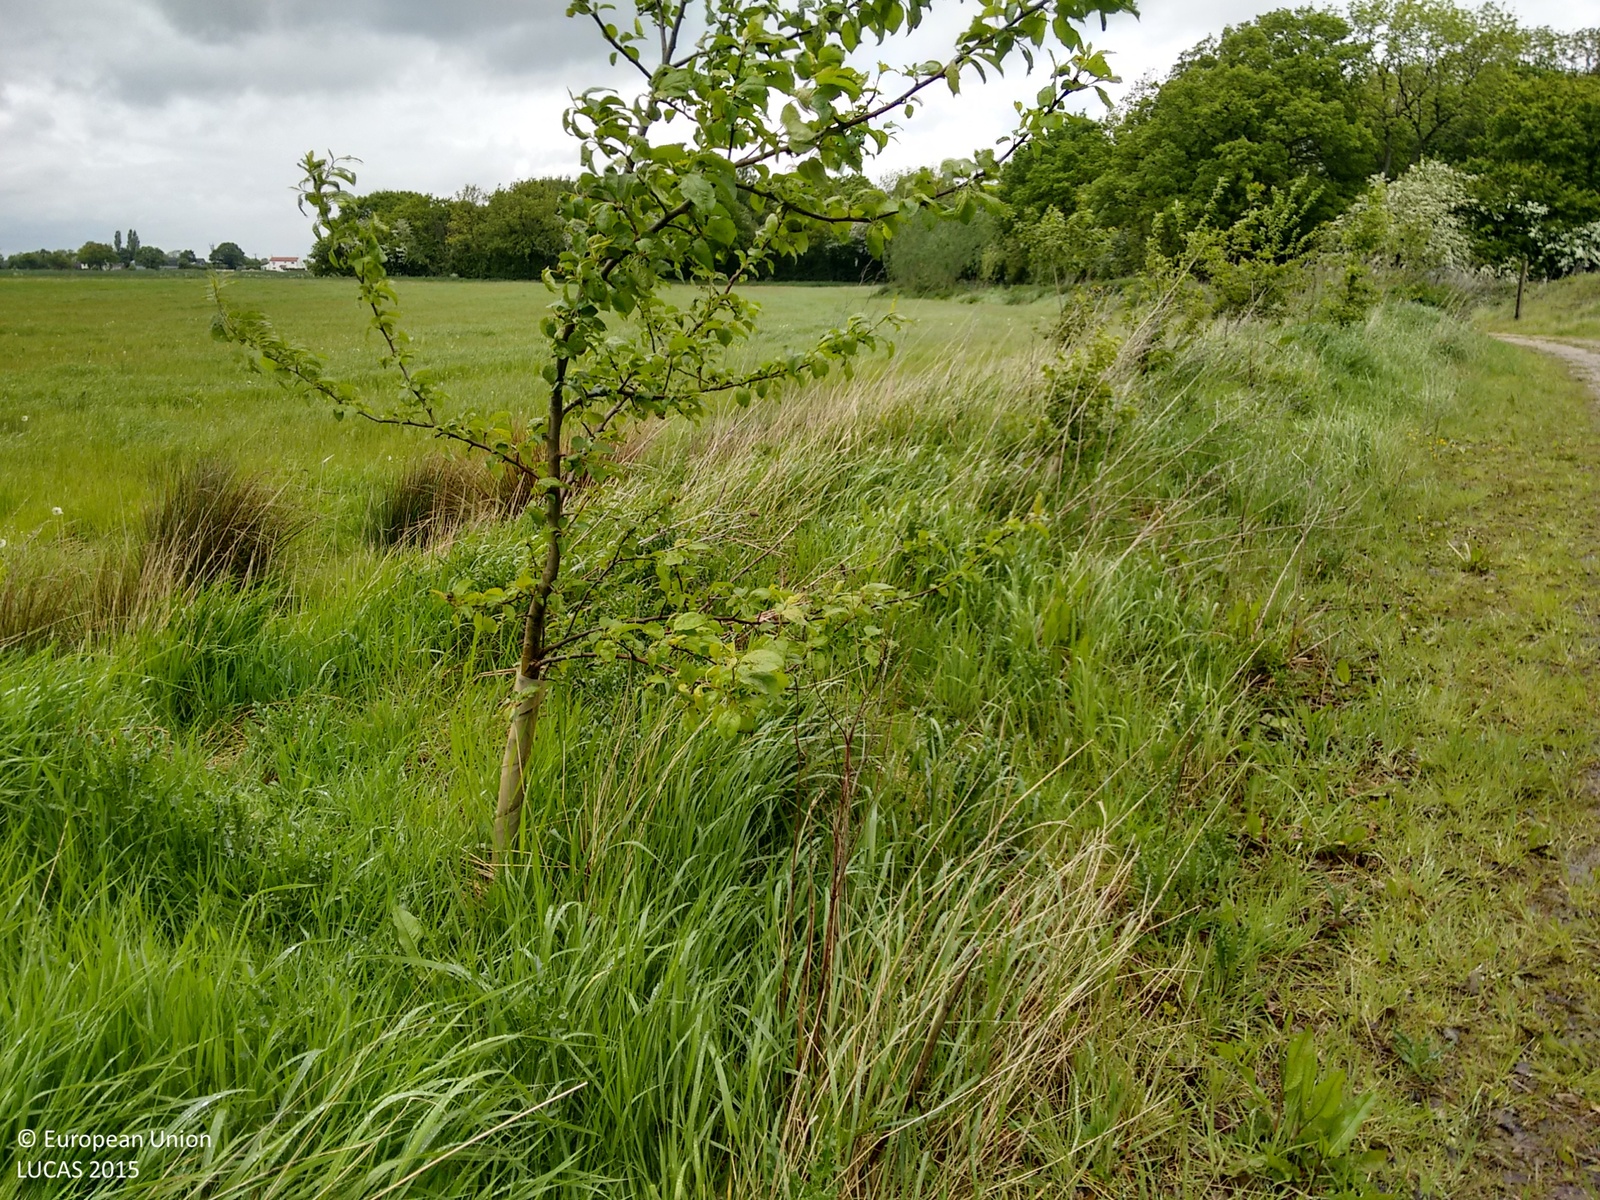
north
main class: Grassland
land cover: Grassland without tree/shrub cover
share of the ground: > 75 %
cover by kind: herbaceous plants 100 %
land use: Agriculture (excluding fallow land and kitchen gardens)
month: May
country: GB
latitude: 53.6138
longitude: -1.1249
